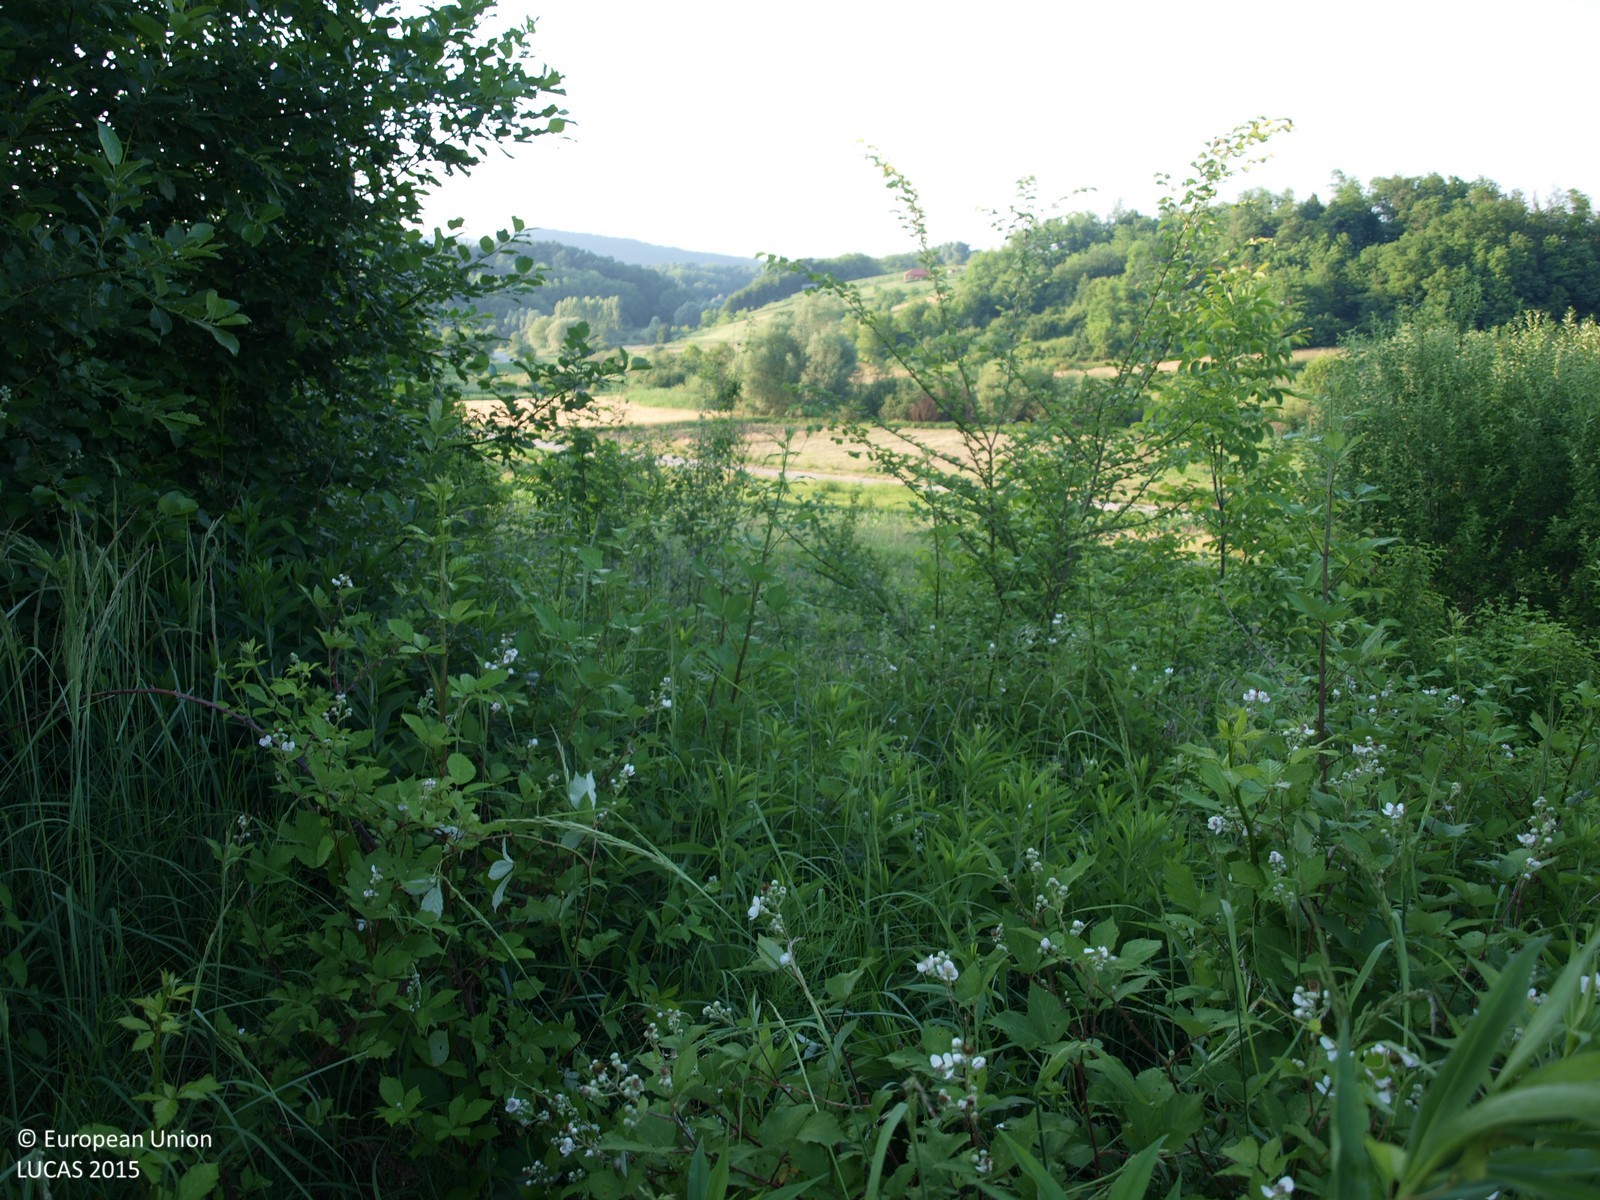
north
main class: Shrubland
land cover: Shrubland with sparse tree cover
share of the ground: > 75 %
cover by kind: shrubs 85 %, herbaceous plants 10 %, broadleaved forest trees 5 %
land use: Semi-natural and natural areas not in use
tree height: < 5 m
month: June
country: HR
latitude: 46.2174
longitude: 16.0270
